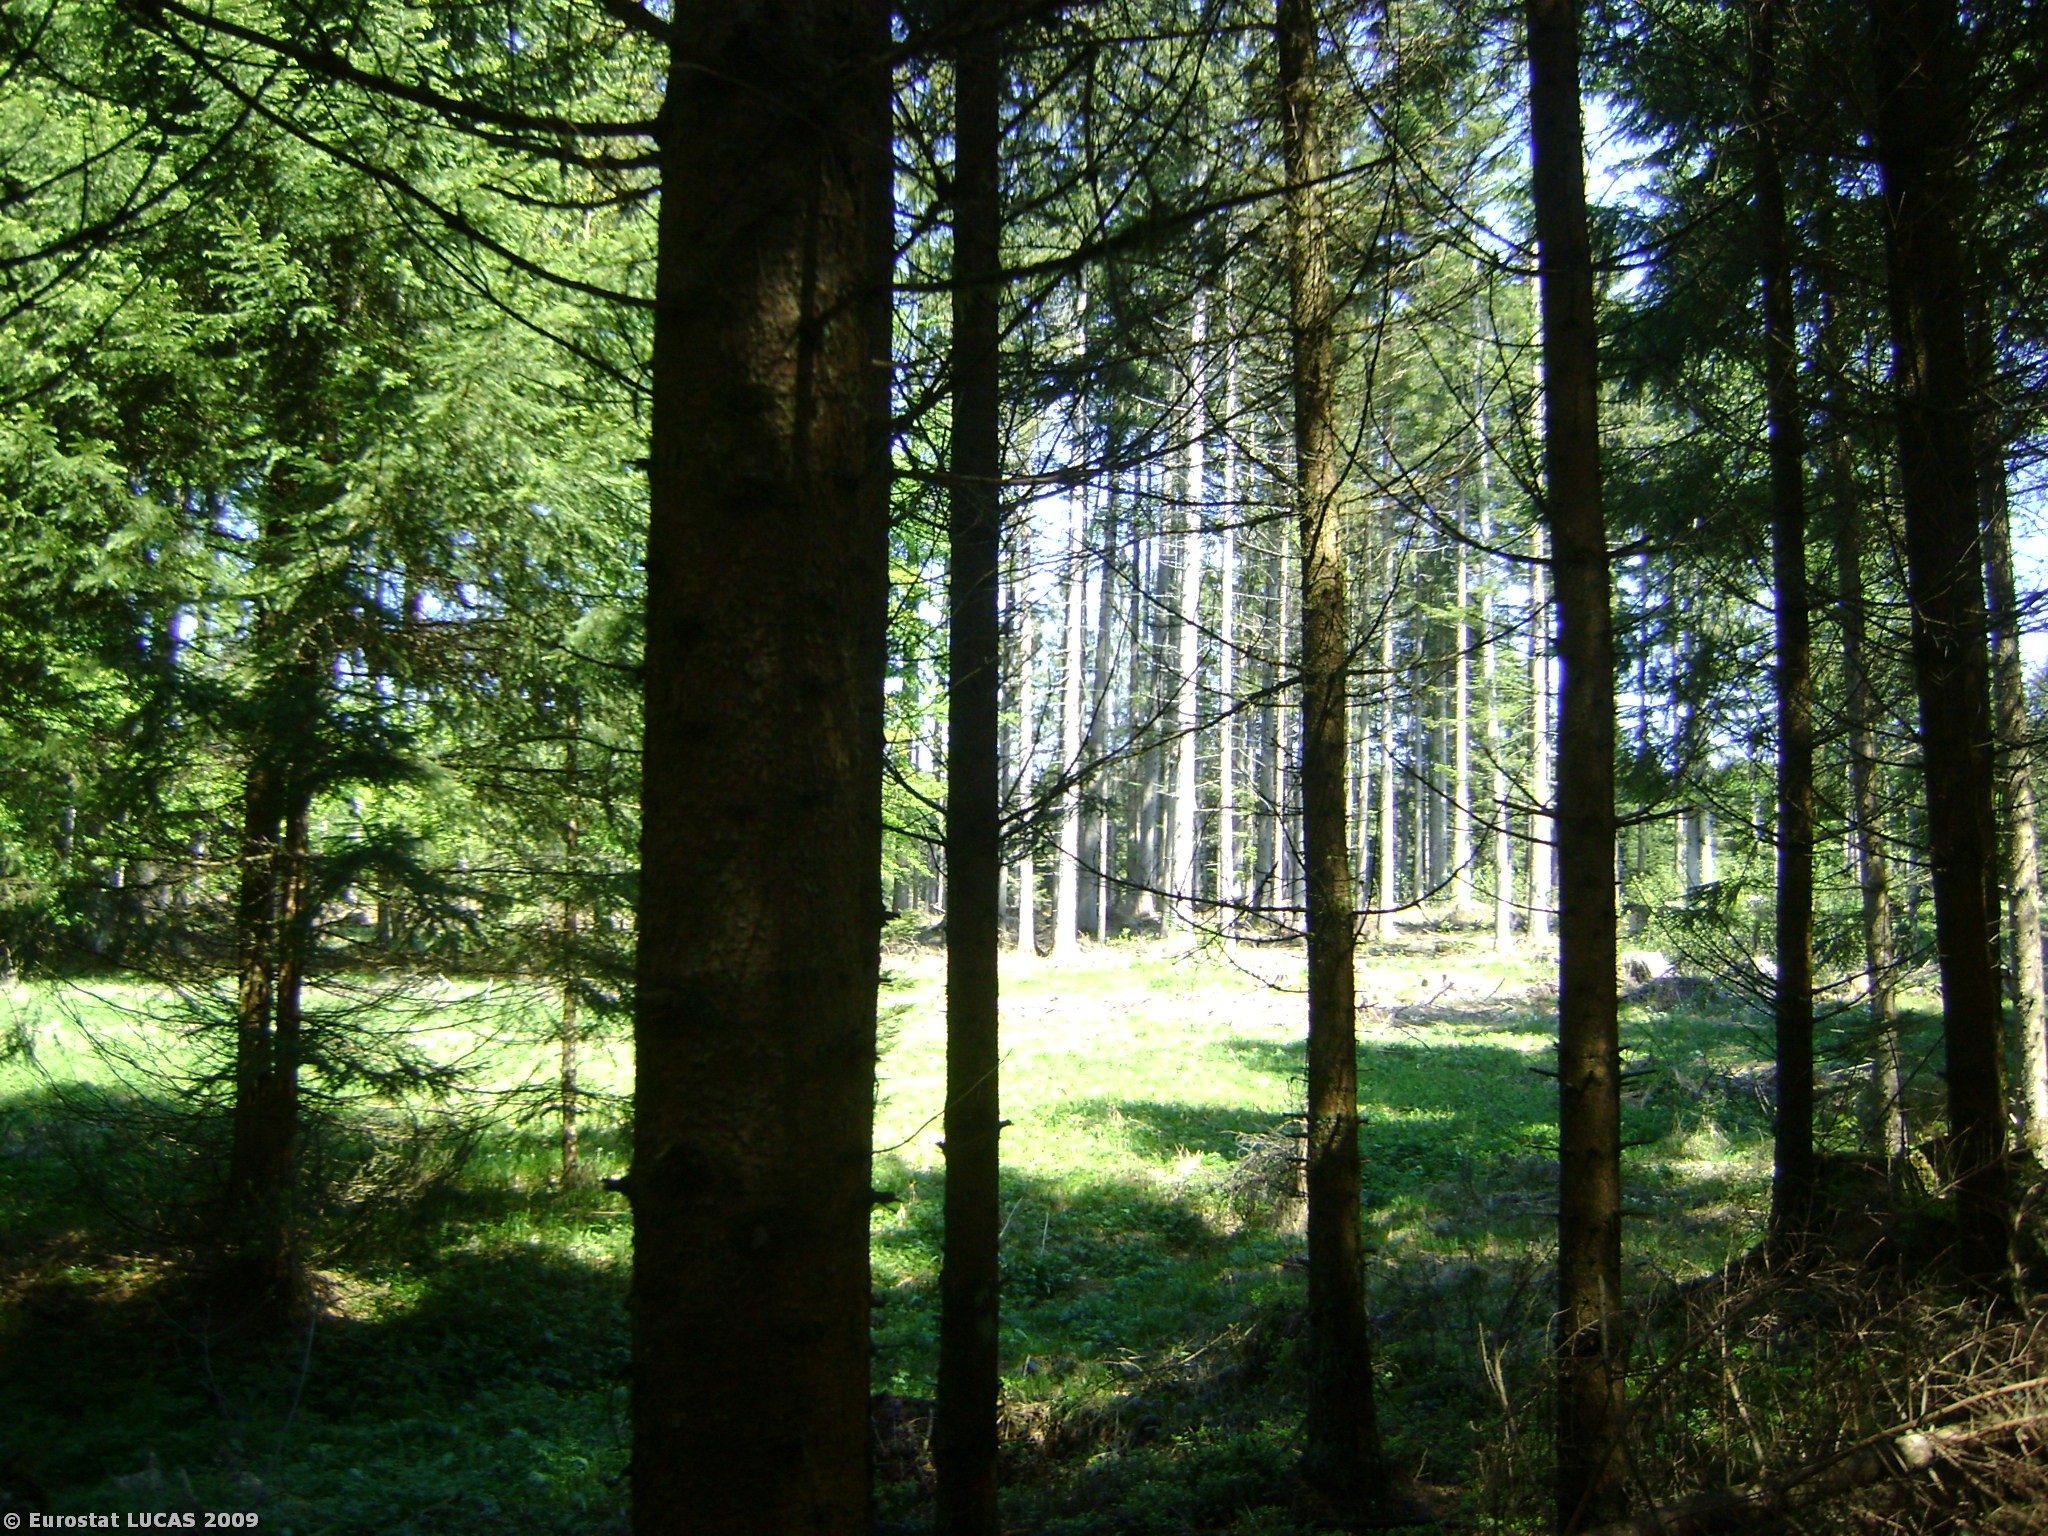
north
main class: Woodland
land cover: Coniferous woodland
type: hemiboreal forest and nemoral coniferous forest and mixed broadleaved-coniferous forest
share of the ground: > 75 %
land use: Forestry
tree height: > 5 m
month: May
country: AT
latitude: 47.8516
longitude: 13.2463
